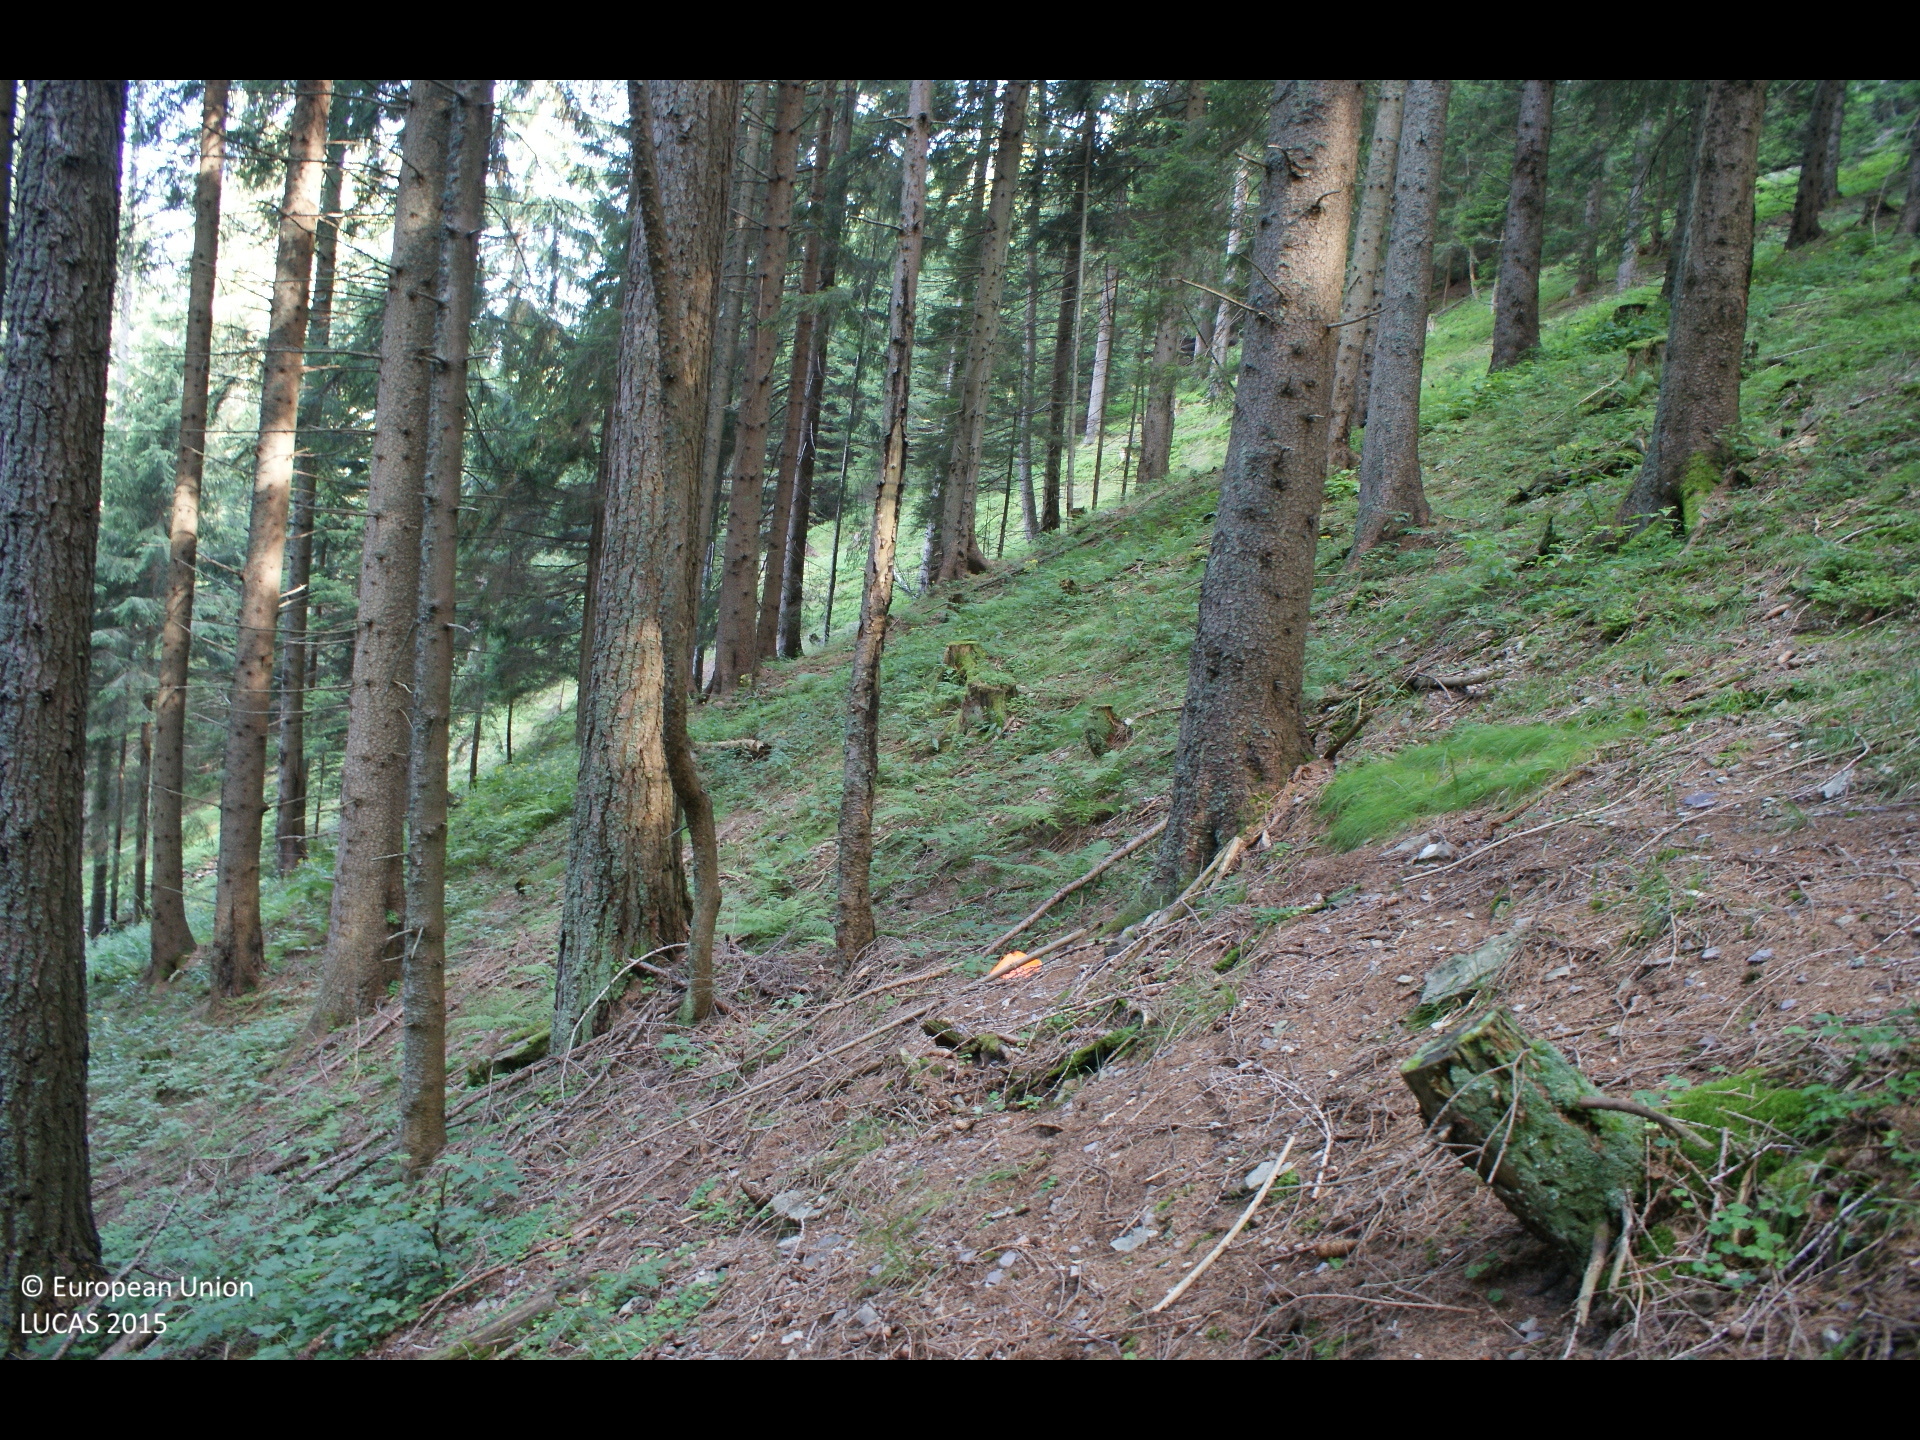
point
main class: Woodland
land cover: Spruce dominated coniferous woodland
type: alpine coniferous forest
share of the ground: > 75 %
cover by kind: coniferous forest trees 85 %, shrubs 5 %, herbaceous plants 5 %, lichens and mosses 5 %
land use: Forestry
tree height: > 5 m
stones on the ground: > 50 %
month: August
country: AT
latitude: 47.6446
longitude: 15.3122
